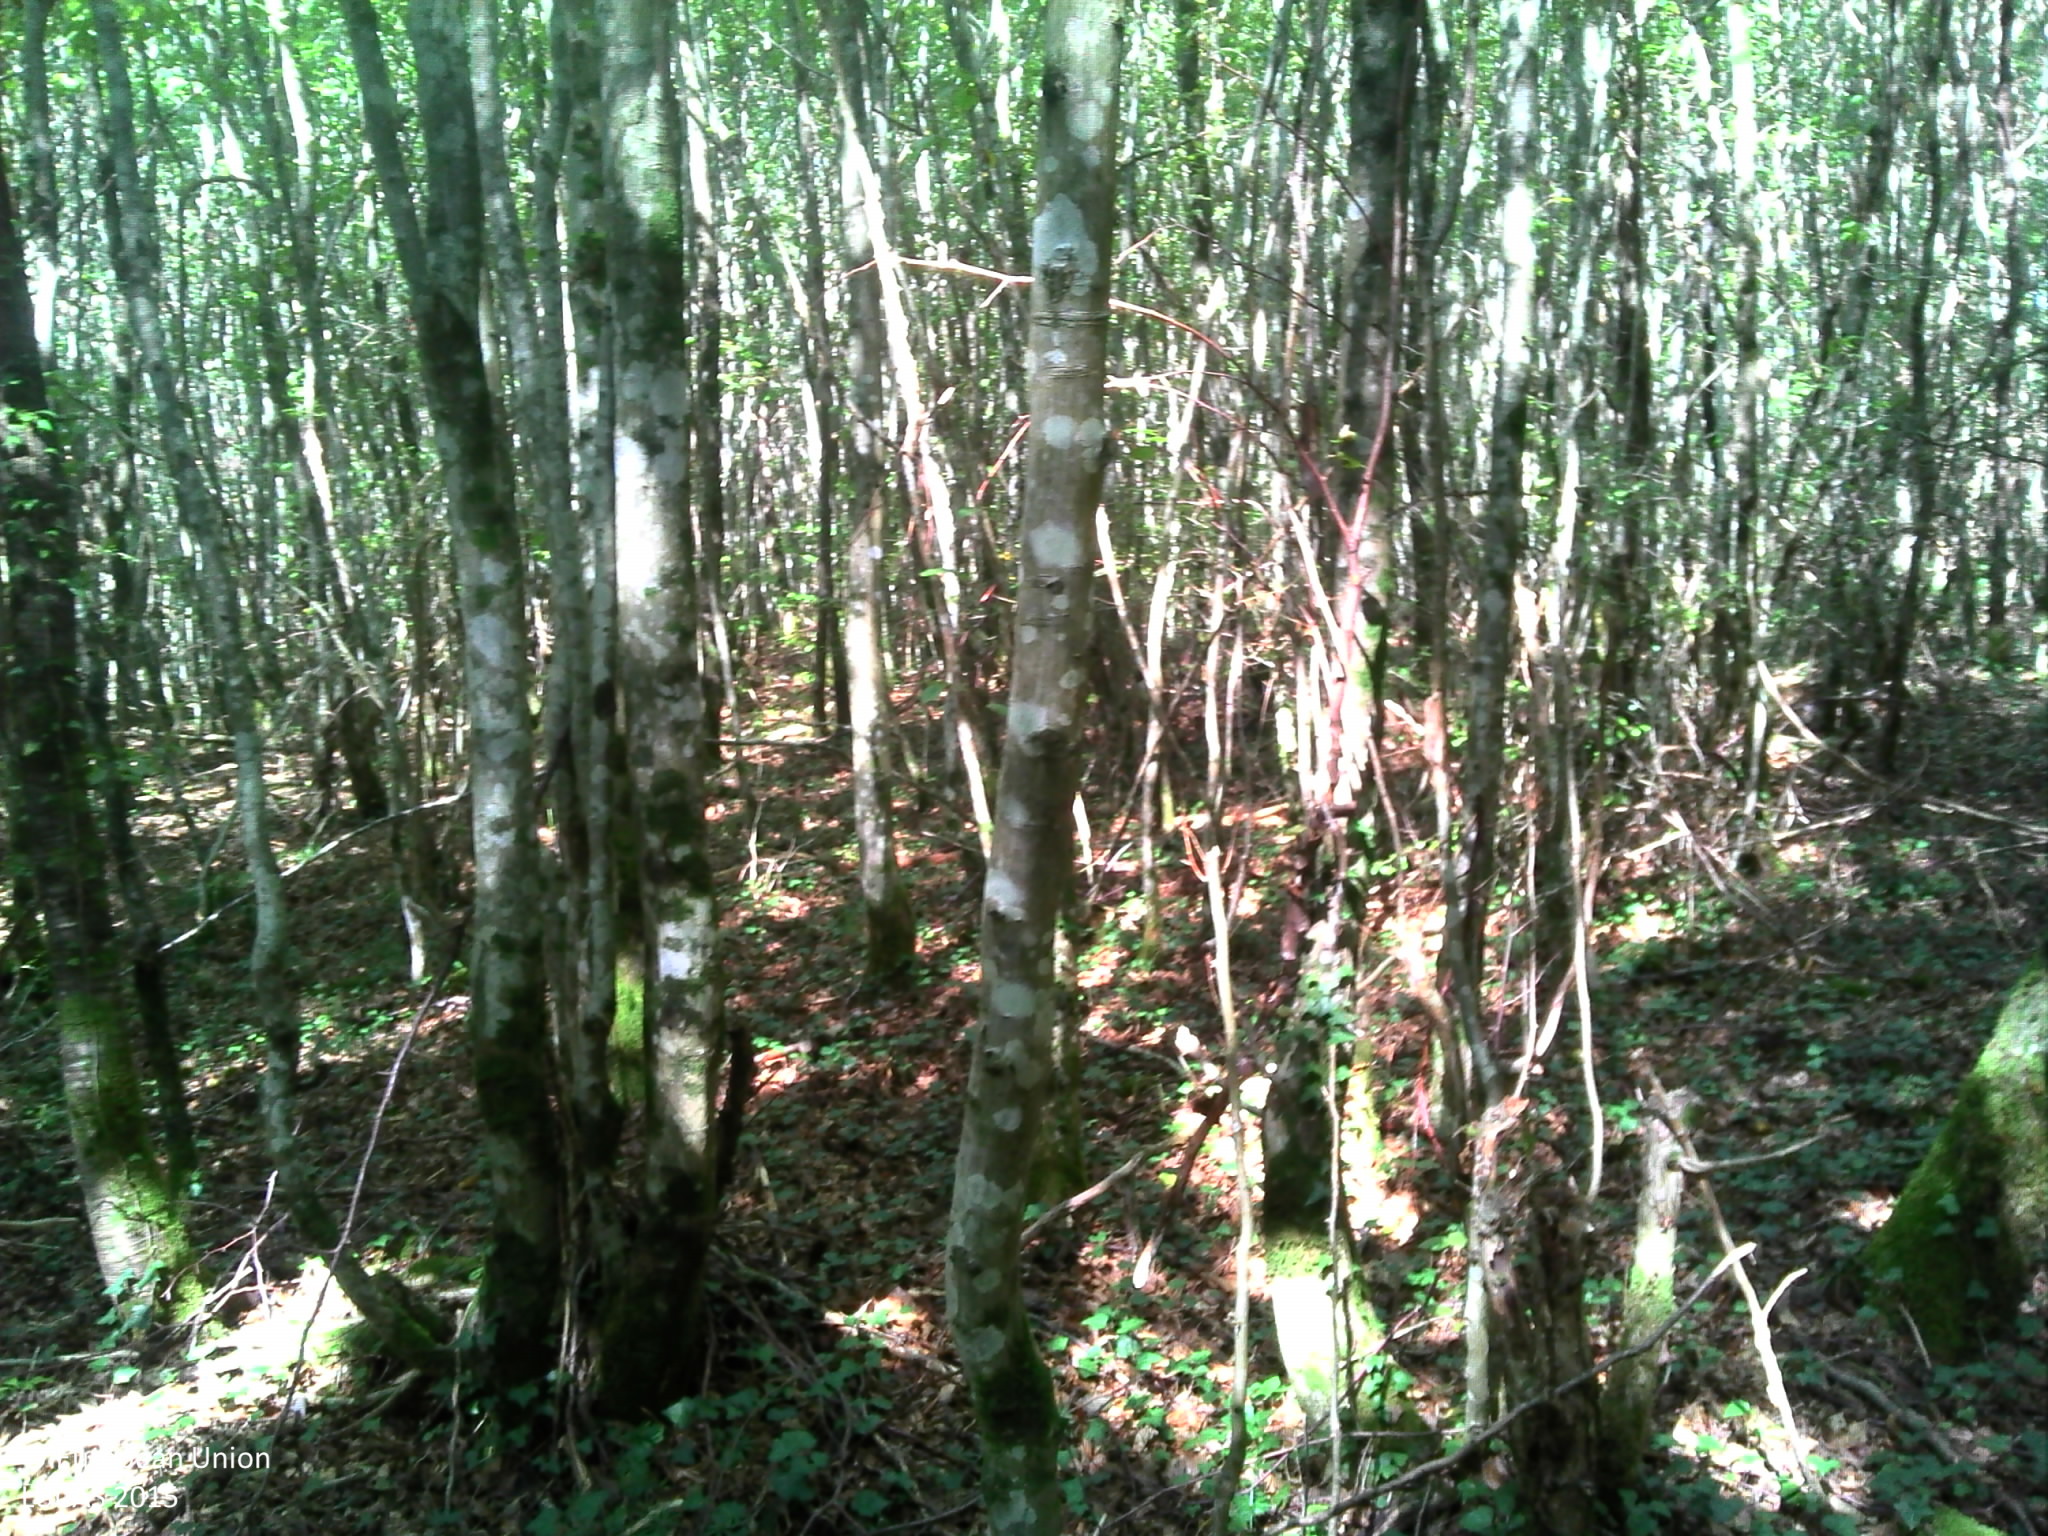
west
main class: Woodland
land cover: Broadleaved woodland
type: beech forest
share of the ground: > 75 %
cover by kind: broadleaved forest trees 90 %, unconsolidated bare surface 10 %
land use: Forestry
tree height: > 5 m
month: September
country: FR
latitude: 47.3672
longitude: 6.2542
